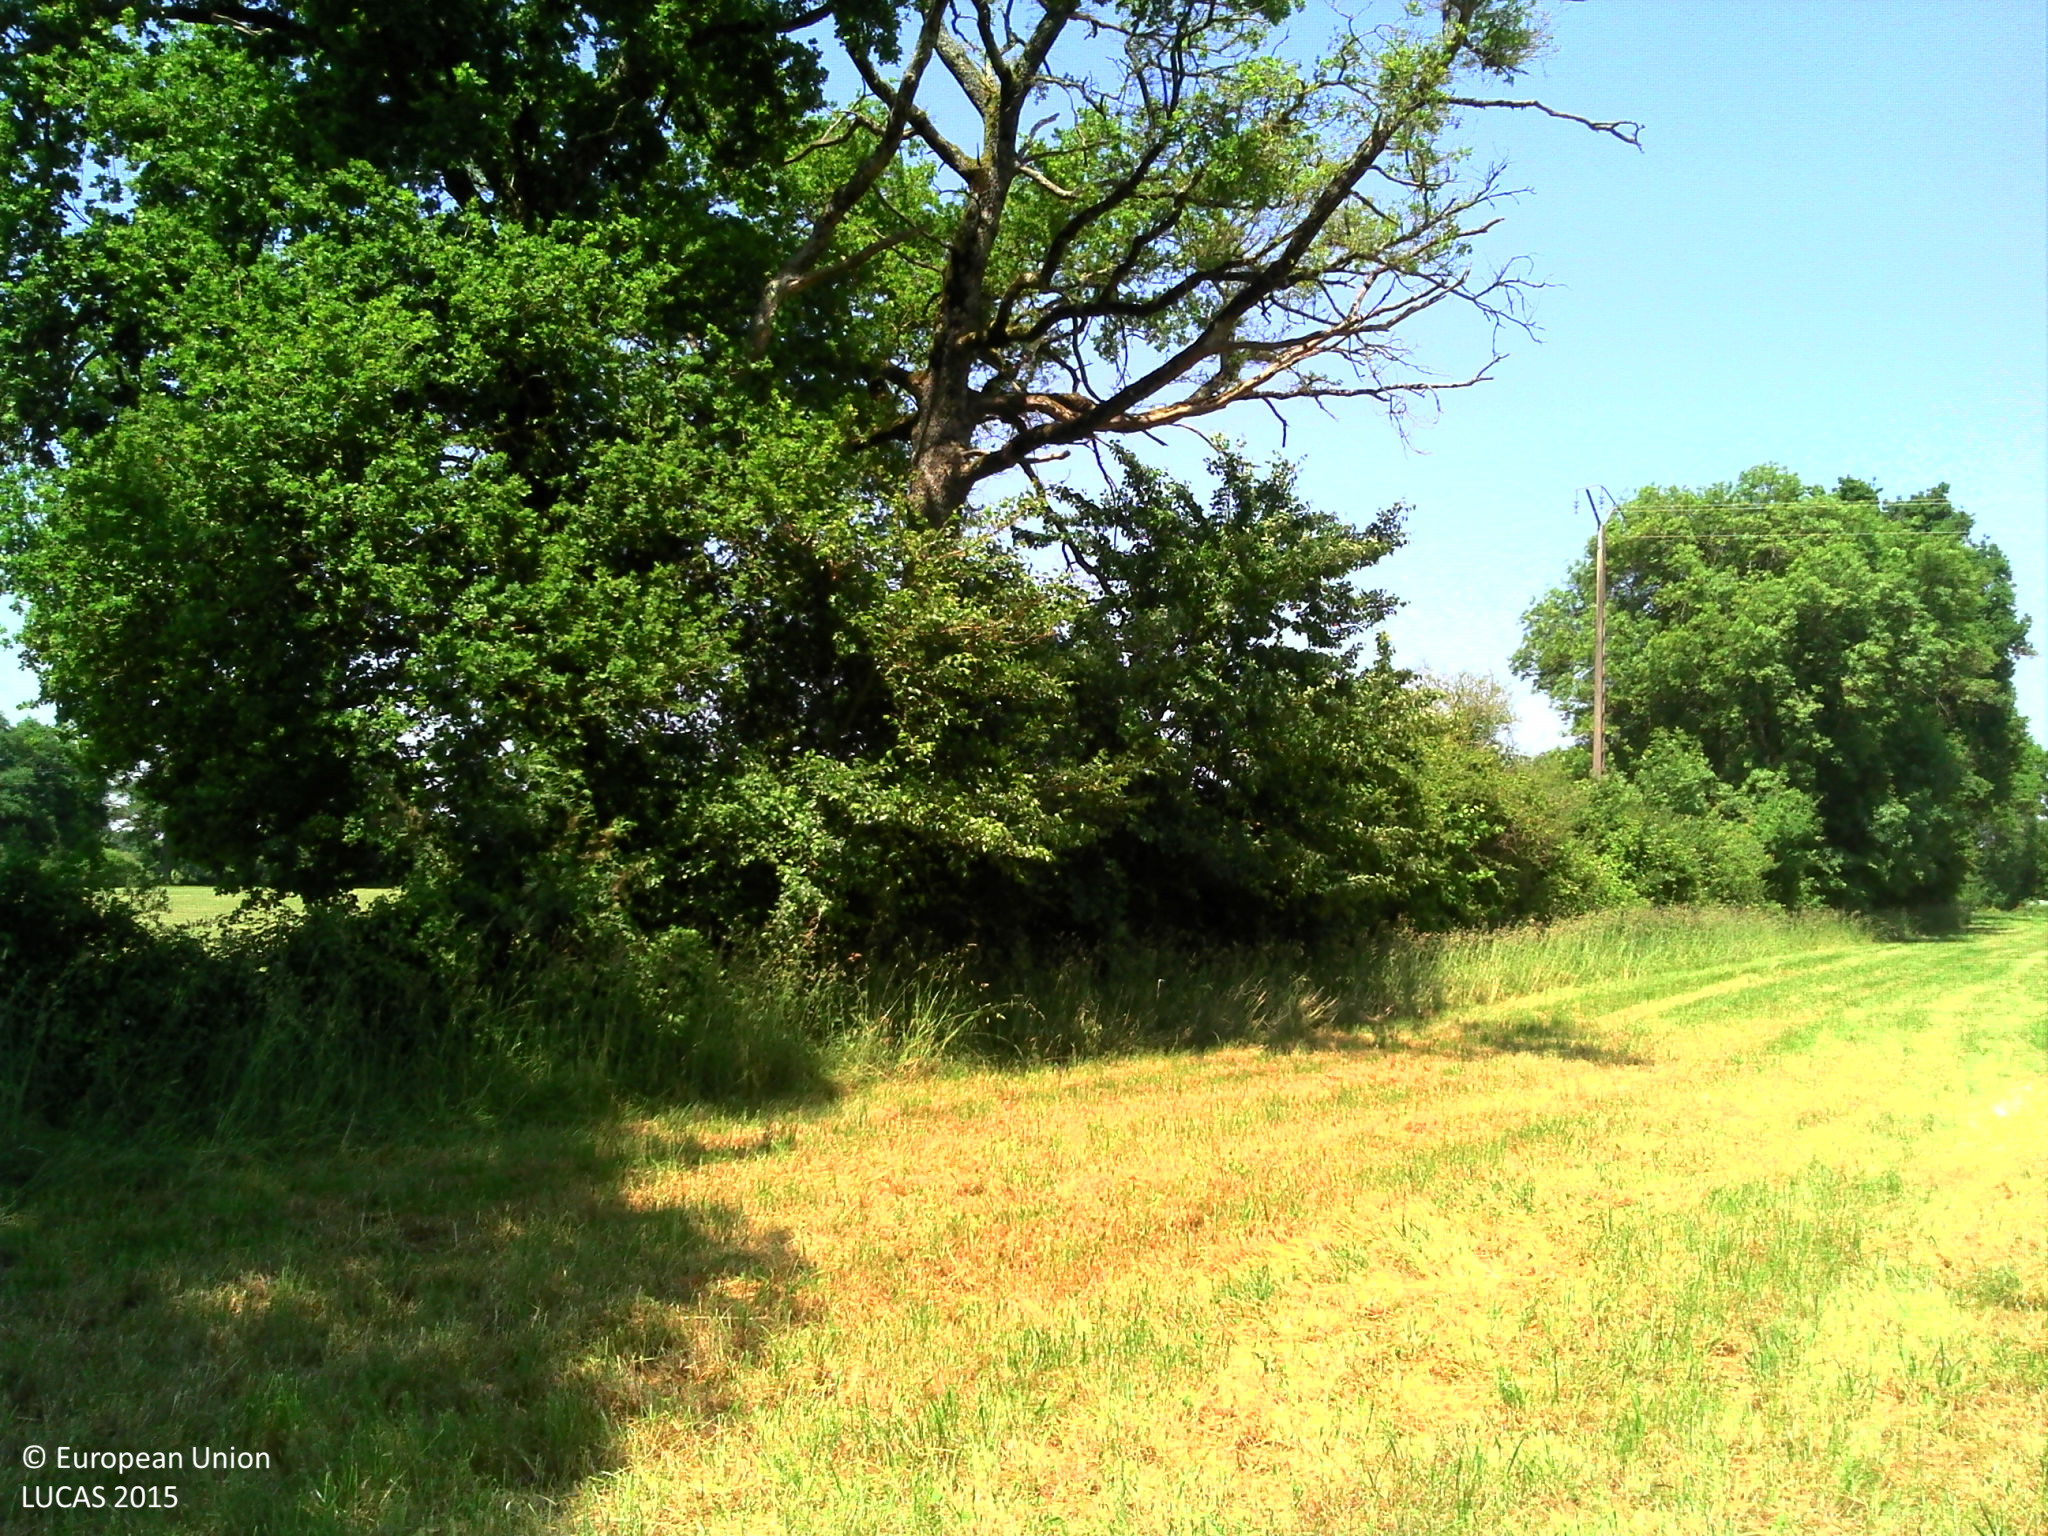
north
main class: Grassland
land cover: Grassland without tree/shrub cover
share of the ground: > 75 %
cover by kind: herbaceous plants 100 %
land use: Agriculture (excluding fallow land and kitchen gardens)
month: June
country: FR
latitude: 46.0778
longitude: 0.5585
